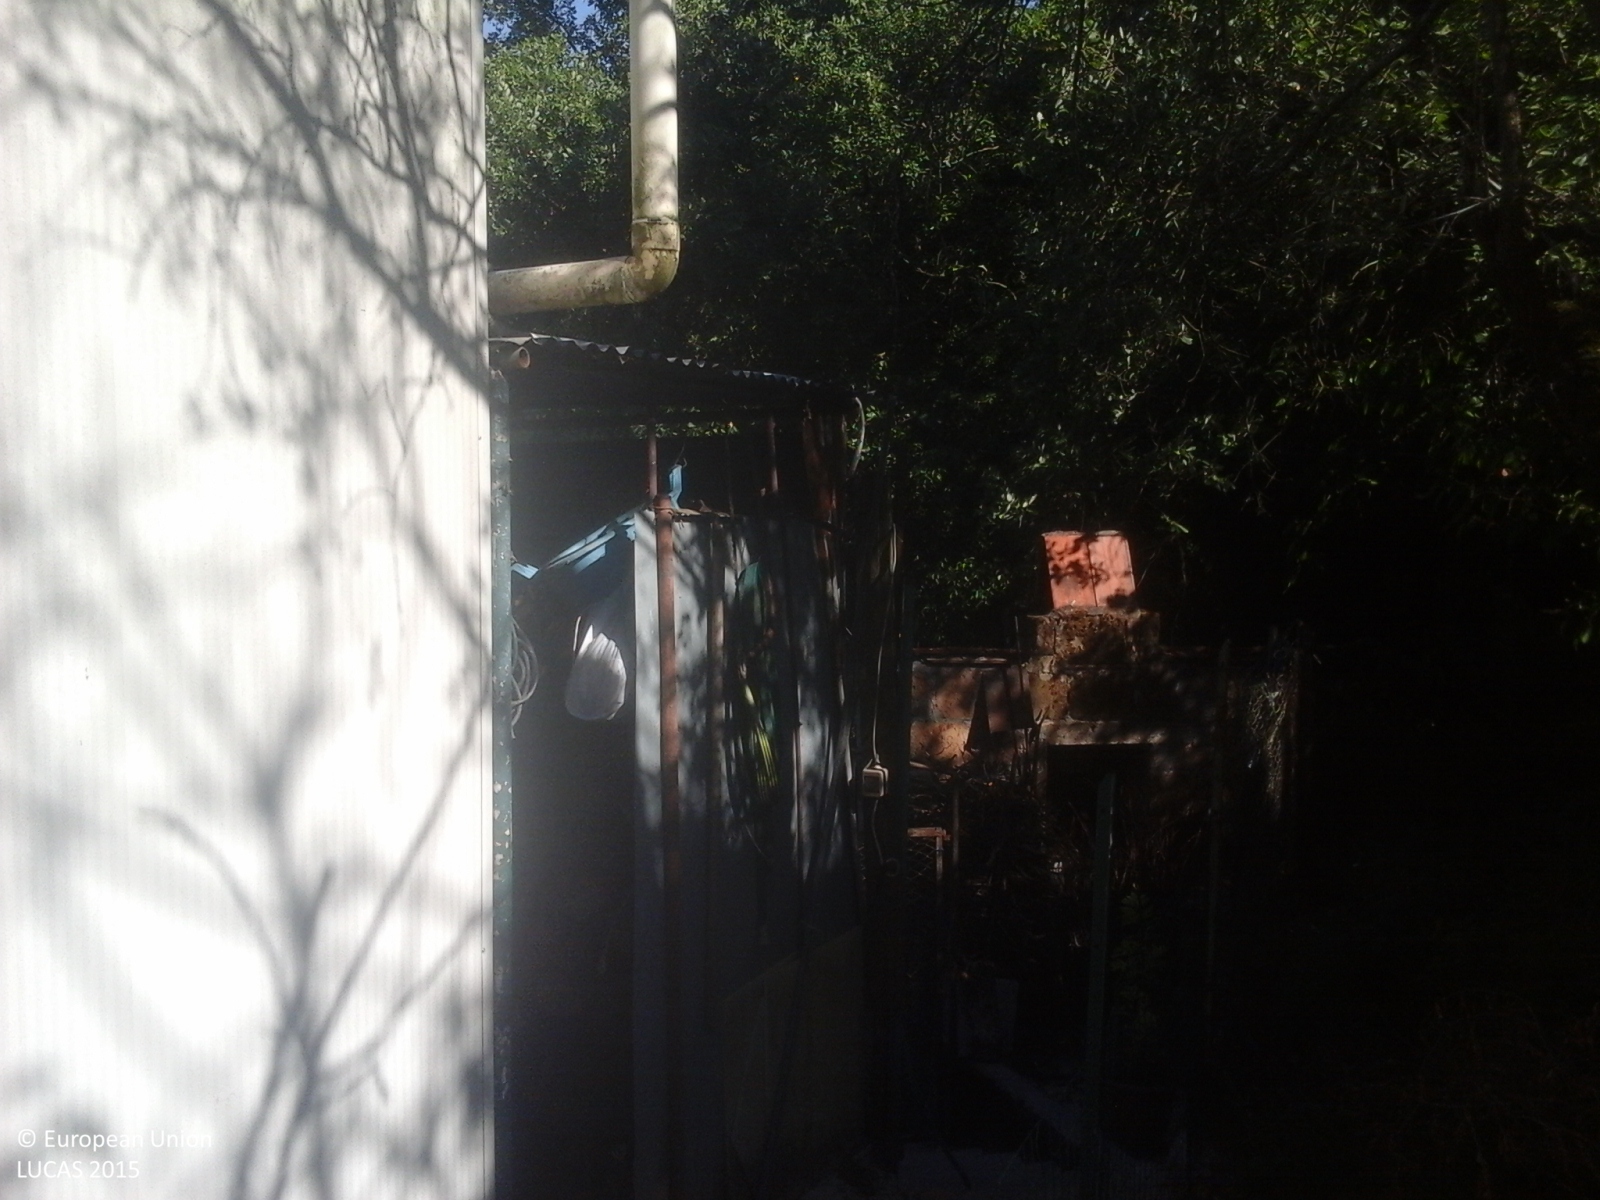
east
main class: Cropland
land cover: Other fruit trees and berries
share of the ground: 25 - 50 %
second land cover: Shrubland without tree cover
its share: > 75 %
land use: Abandoned areas
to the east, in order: Other fruit trees and berries; Shrubland without tree cover; Fences; Other fruit trees and berries; Fences; Broadleaved woodland; Rivers and streams; Broadleaved woodland; Arable land (only in case pi); Broadleaved woodland; Grassland without tree/shrub cover; Olive groves
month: August
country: IT
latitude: 42.5139
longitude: 12.5355
